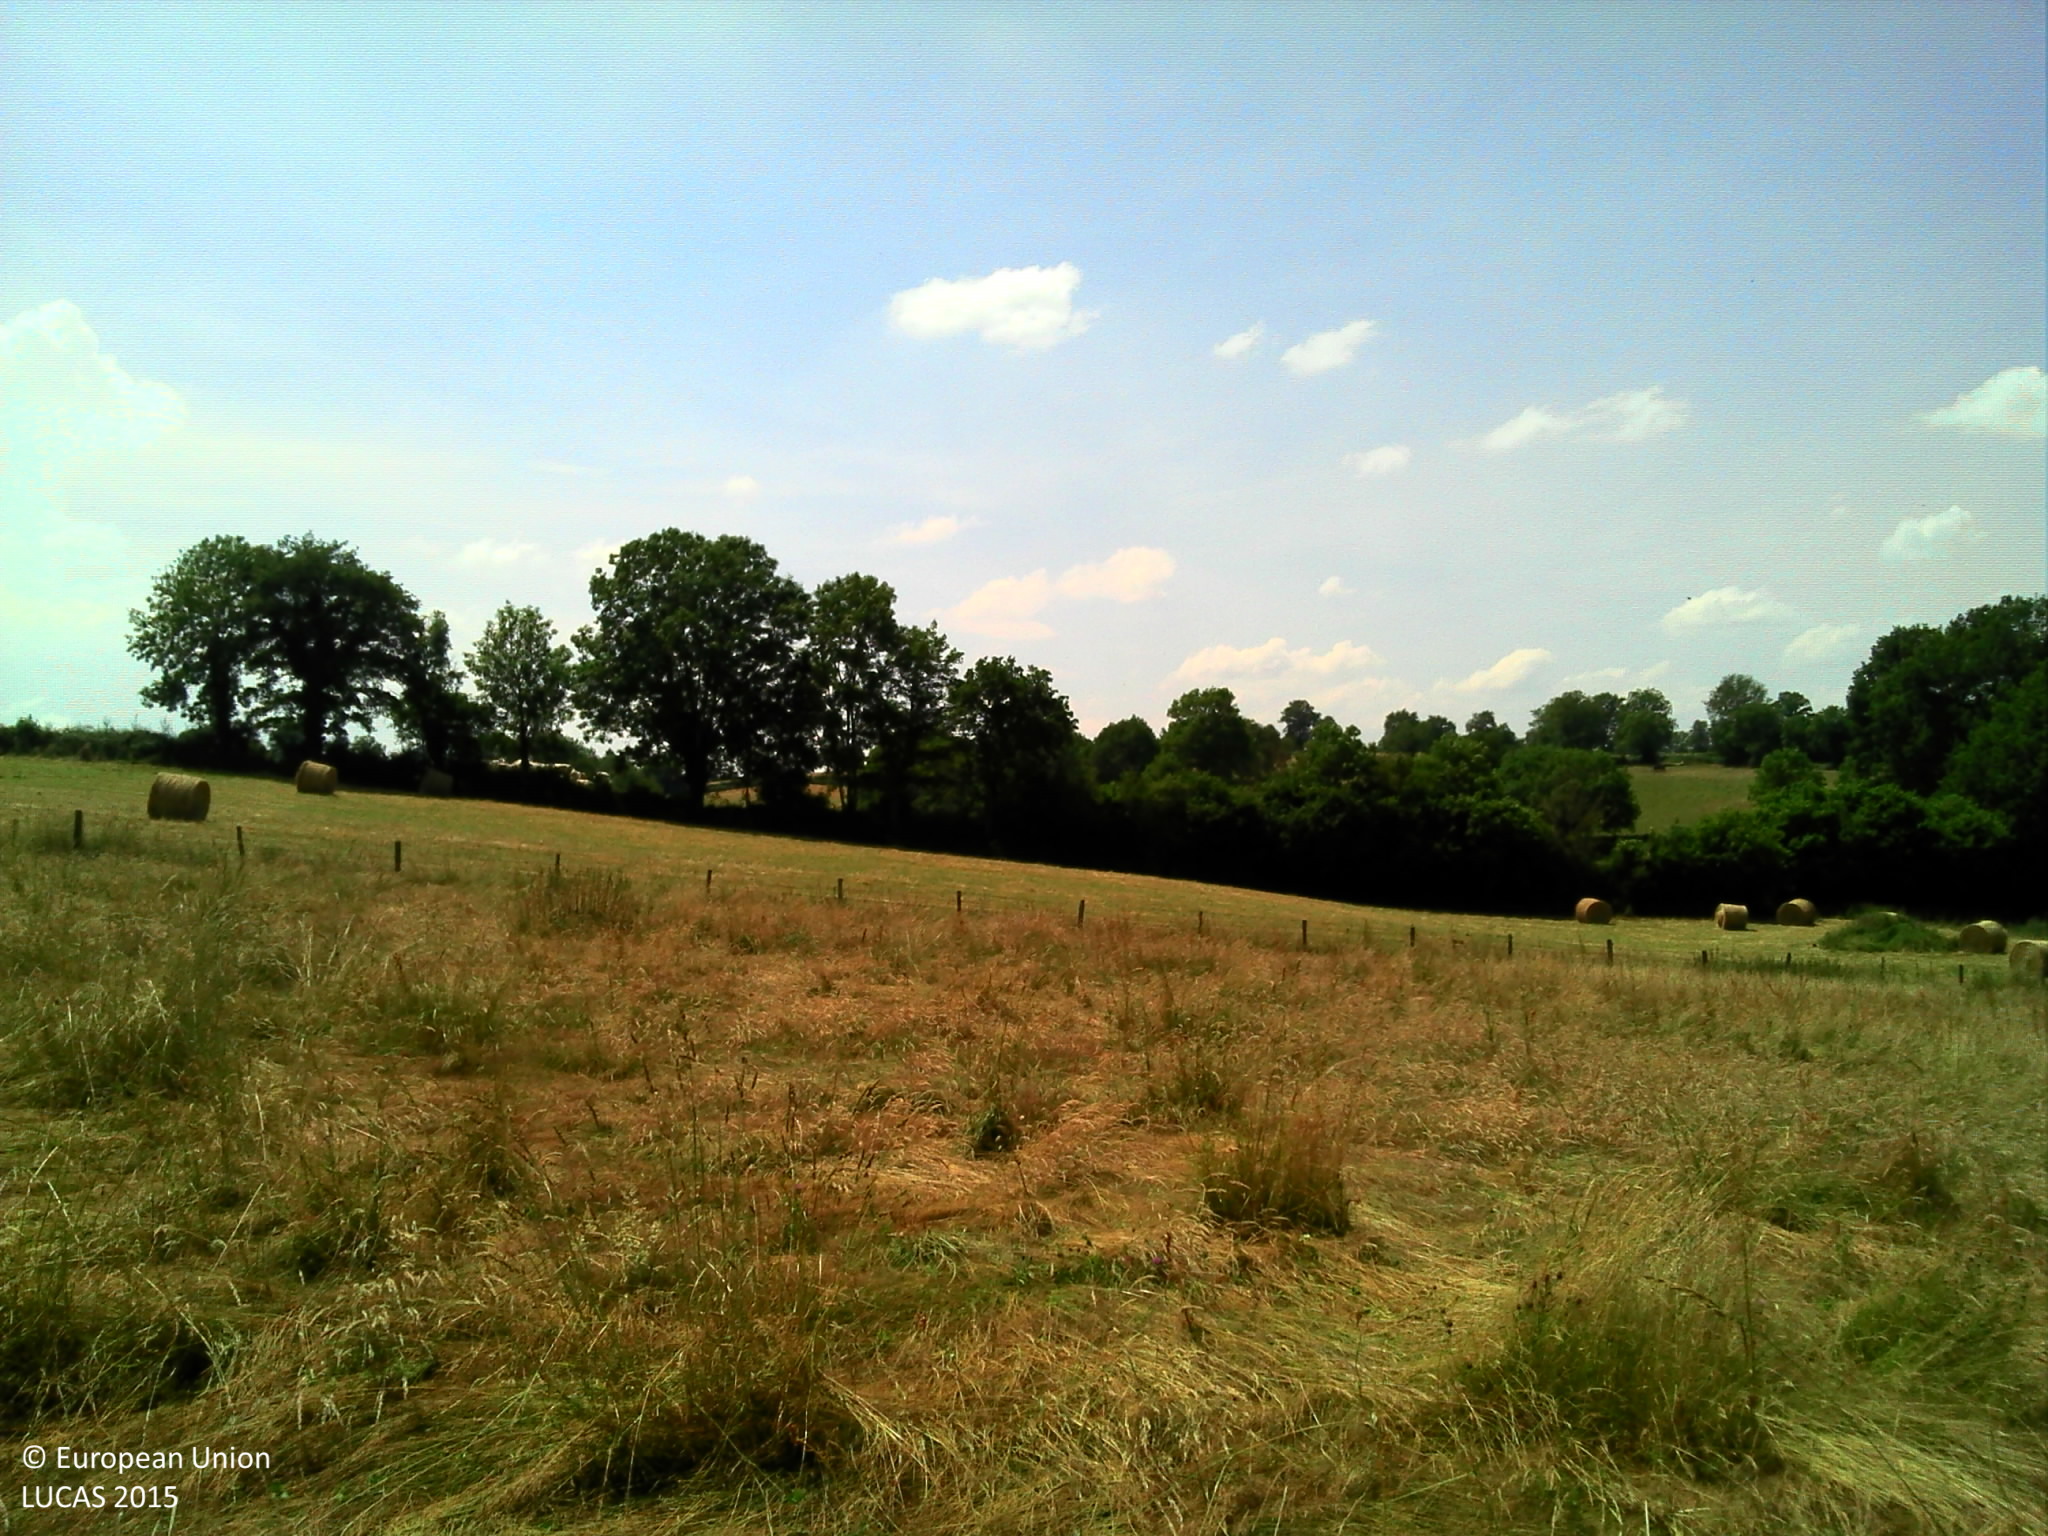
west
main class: Grassland
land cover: Grassland without tree/shrub cover
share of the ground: > 75 %
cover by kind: herbaceous plants 100 %
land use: Agriculture (excluding fallow land and kitchen gardens)
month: June
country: FR
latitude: 46.3400
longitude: 3.0209
